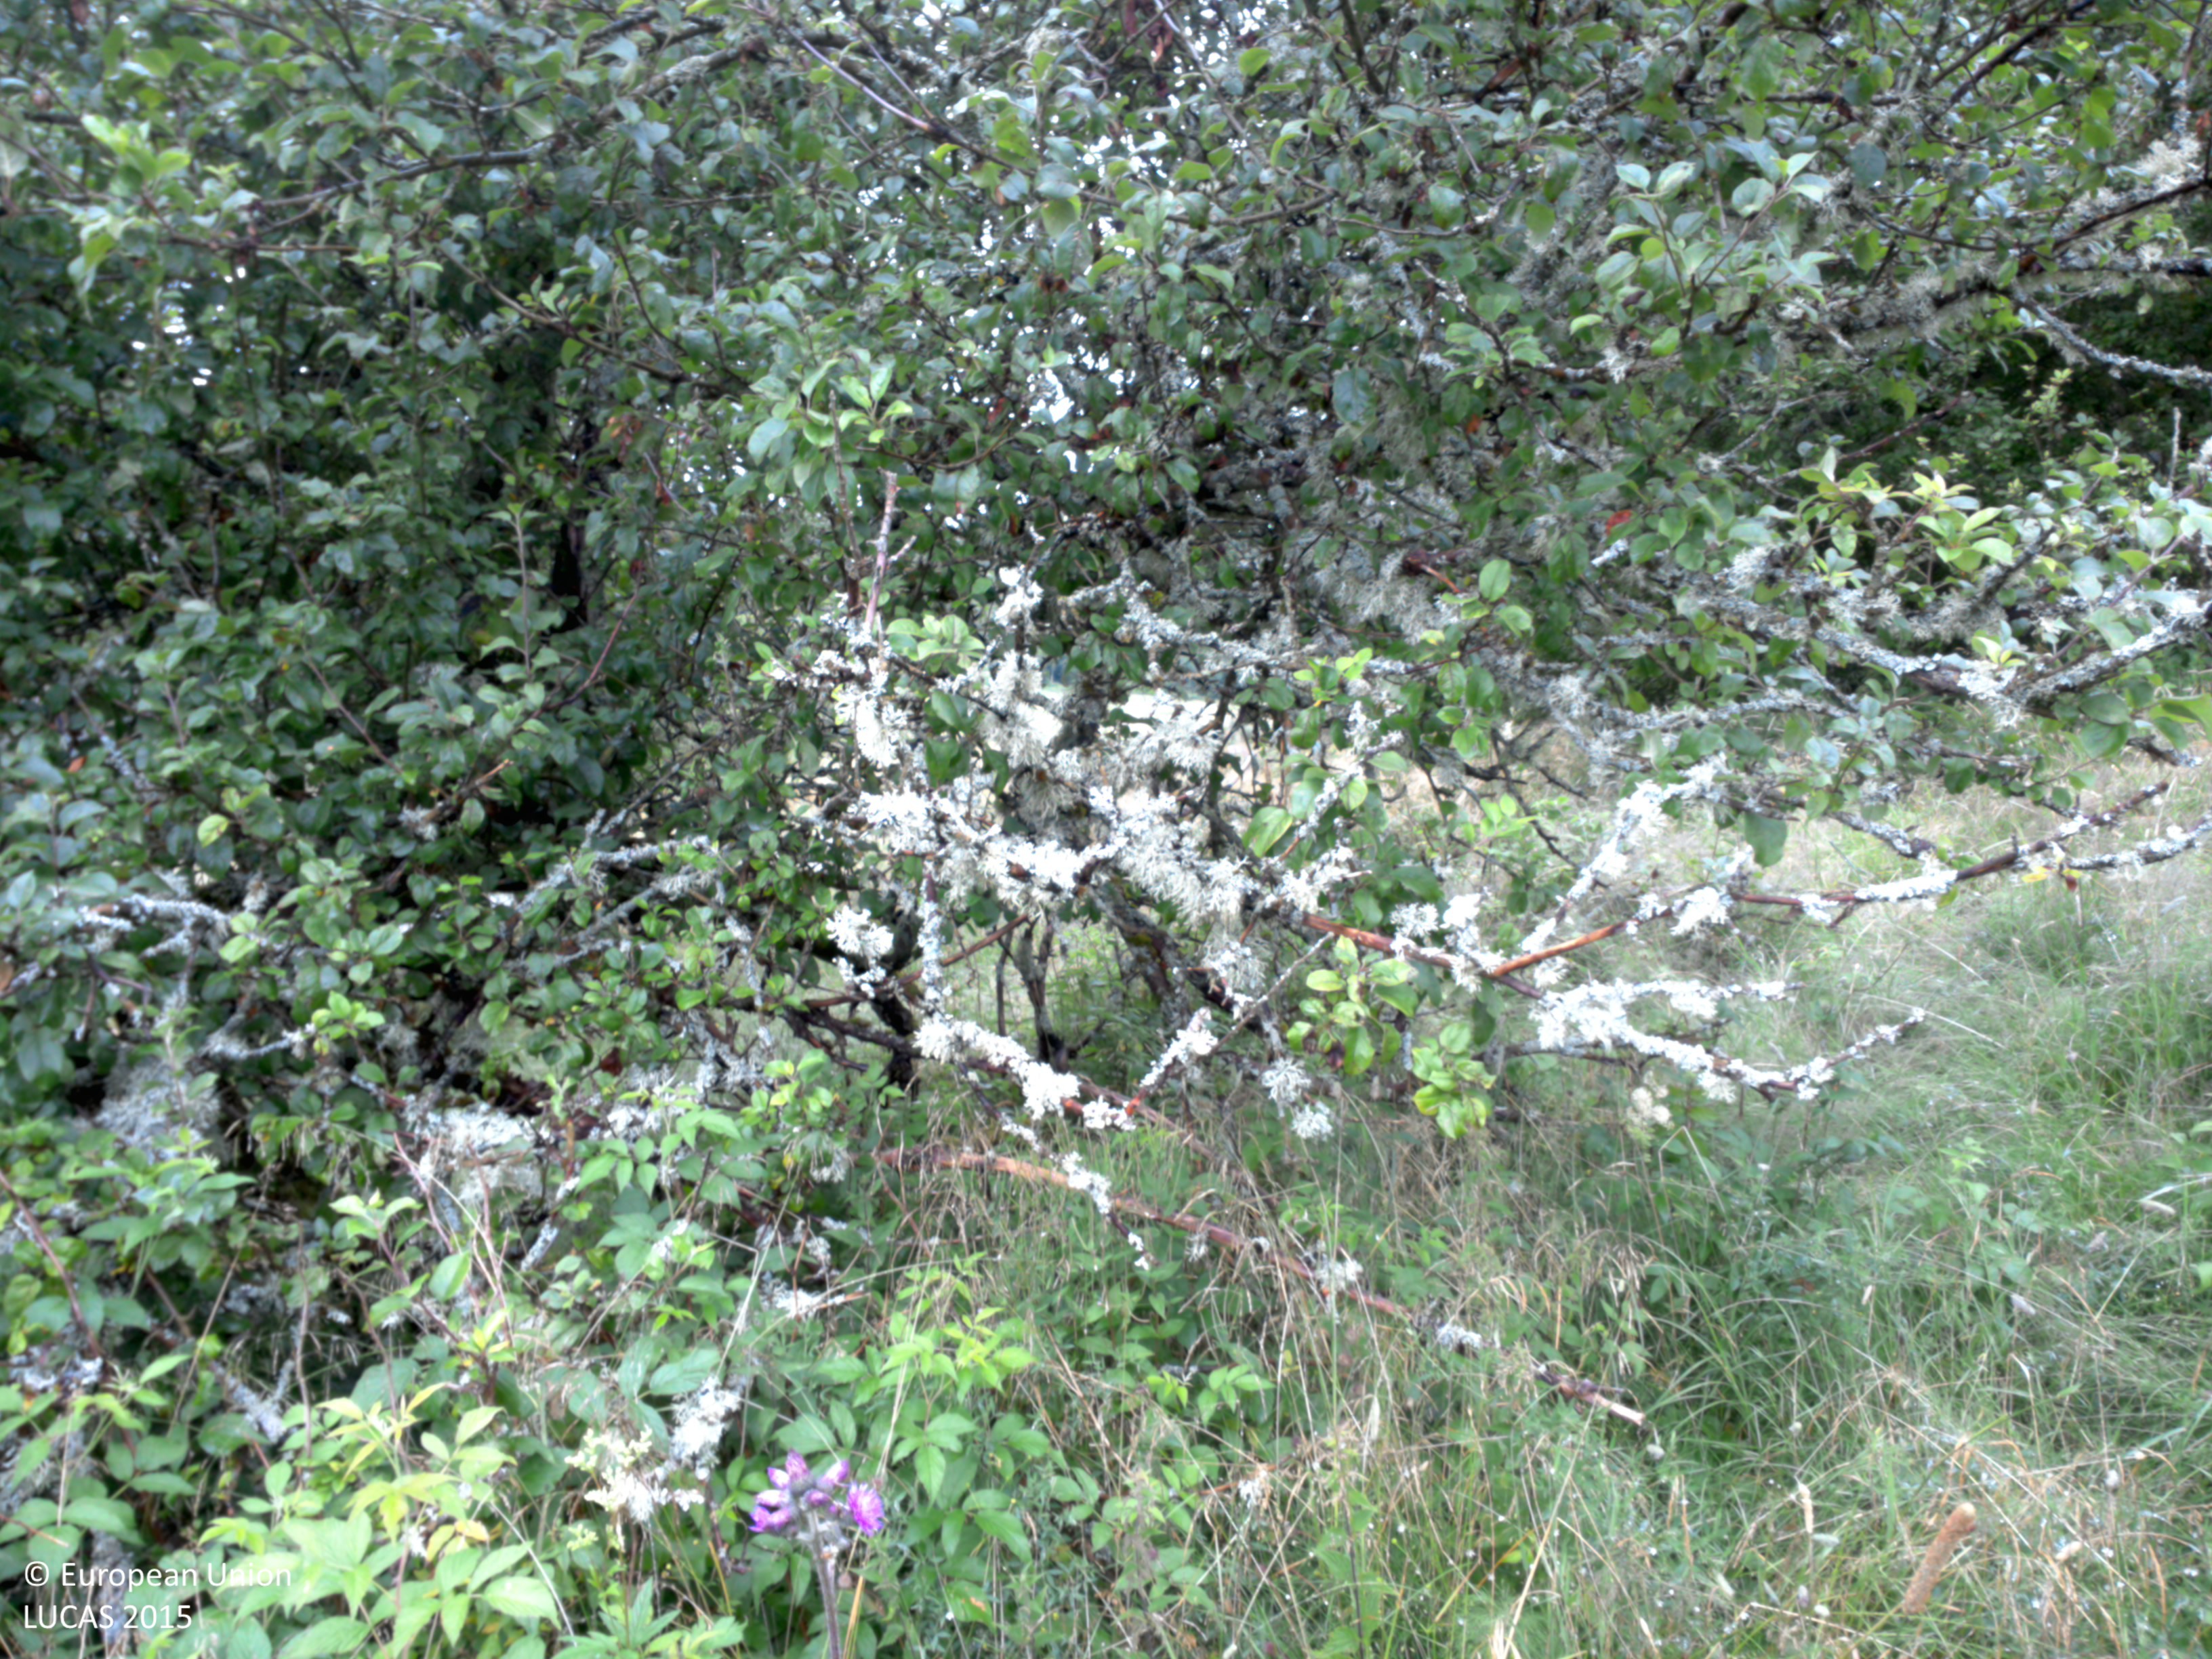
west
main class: Shrubland
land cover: Shrubland with sparse tree cover
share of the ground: > 75 %
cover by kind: herbaceous plants 80 %, shrubs 15 %, broadleaved forest trees 5 %
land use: Agriculture (excluding fallow land and kitchen gardens)
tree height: < 5 m
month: July
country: SE
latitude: 58.7281
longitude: 11.8784
